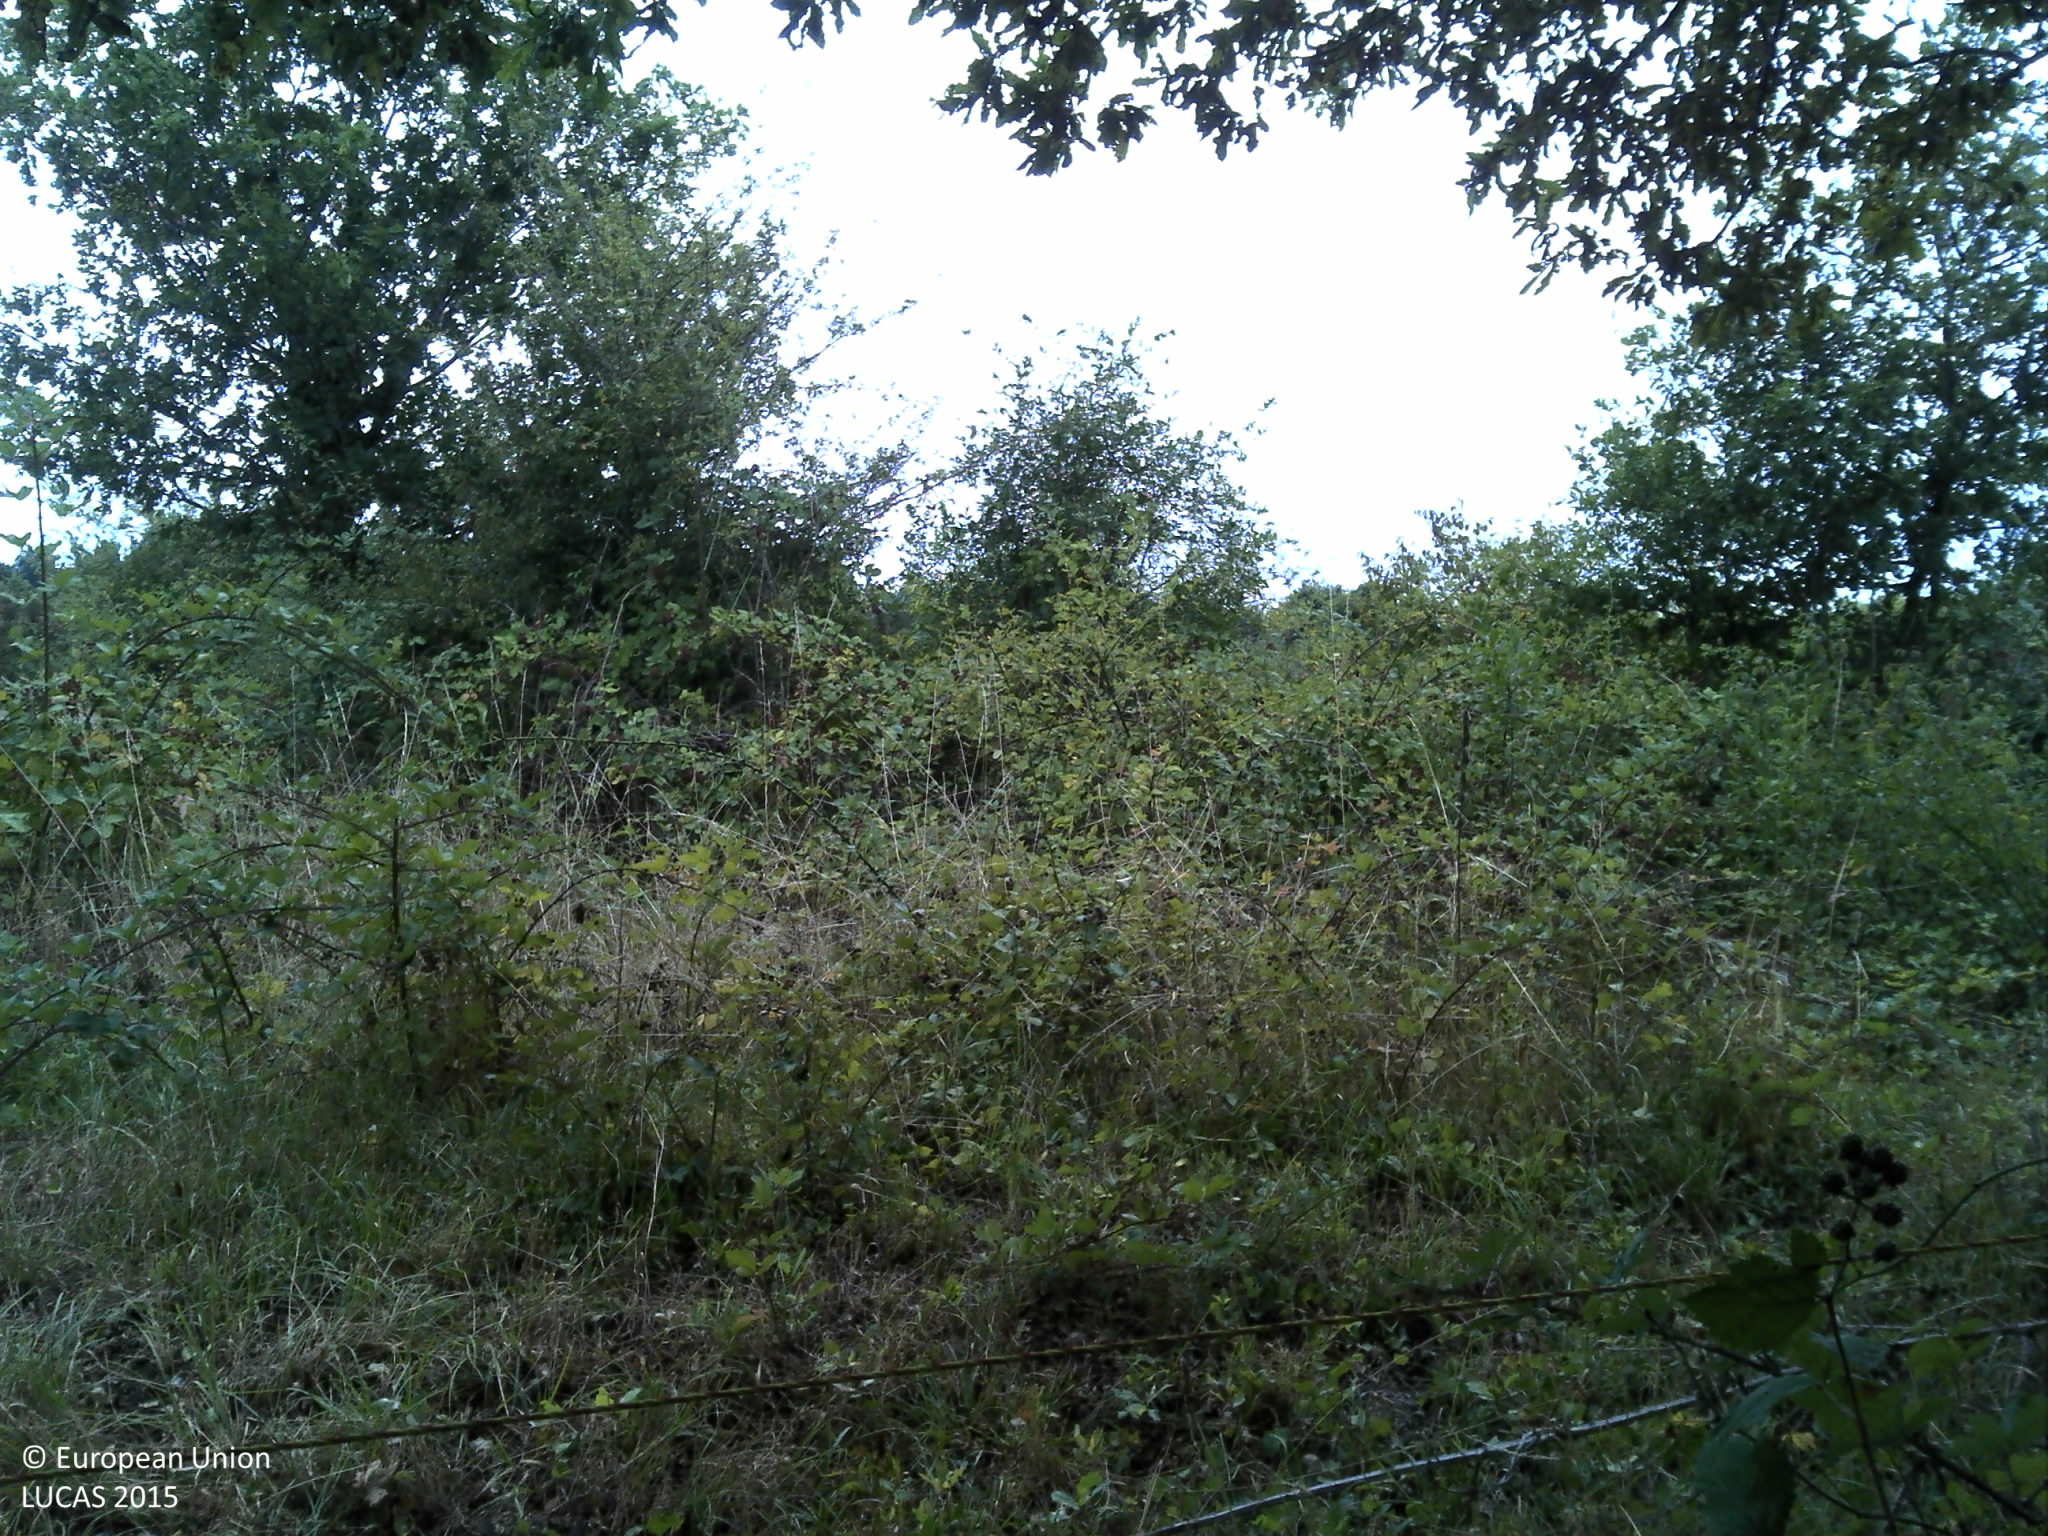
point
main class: Shrubland
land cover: Shrubland with sparse tree cover
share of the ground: > 75 %
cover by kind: herbaceous plants 50 %, shrubs 45 %, broadleaved forest trees 5 %
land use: Agriculture (excluding fallow land and kitchen gardens)
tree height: < 5 m
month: August
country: FR
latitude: 45.1748
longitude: -0.5434
